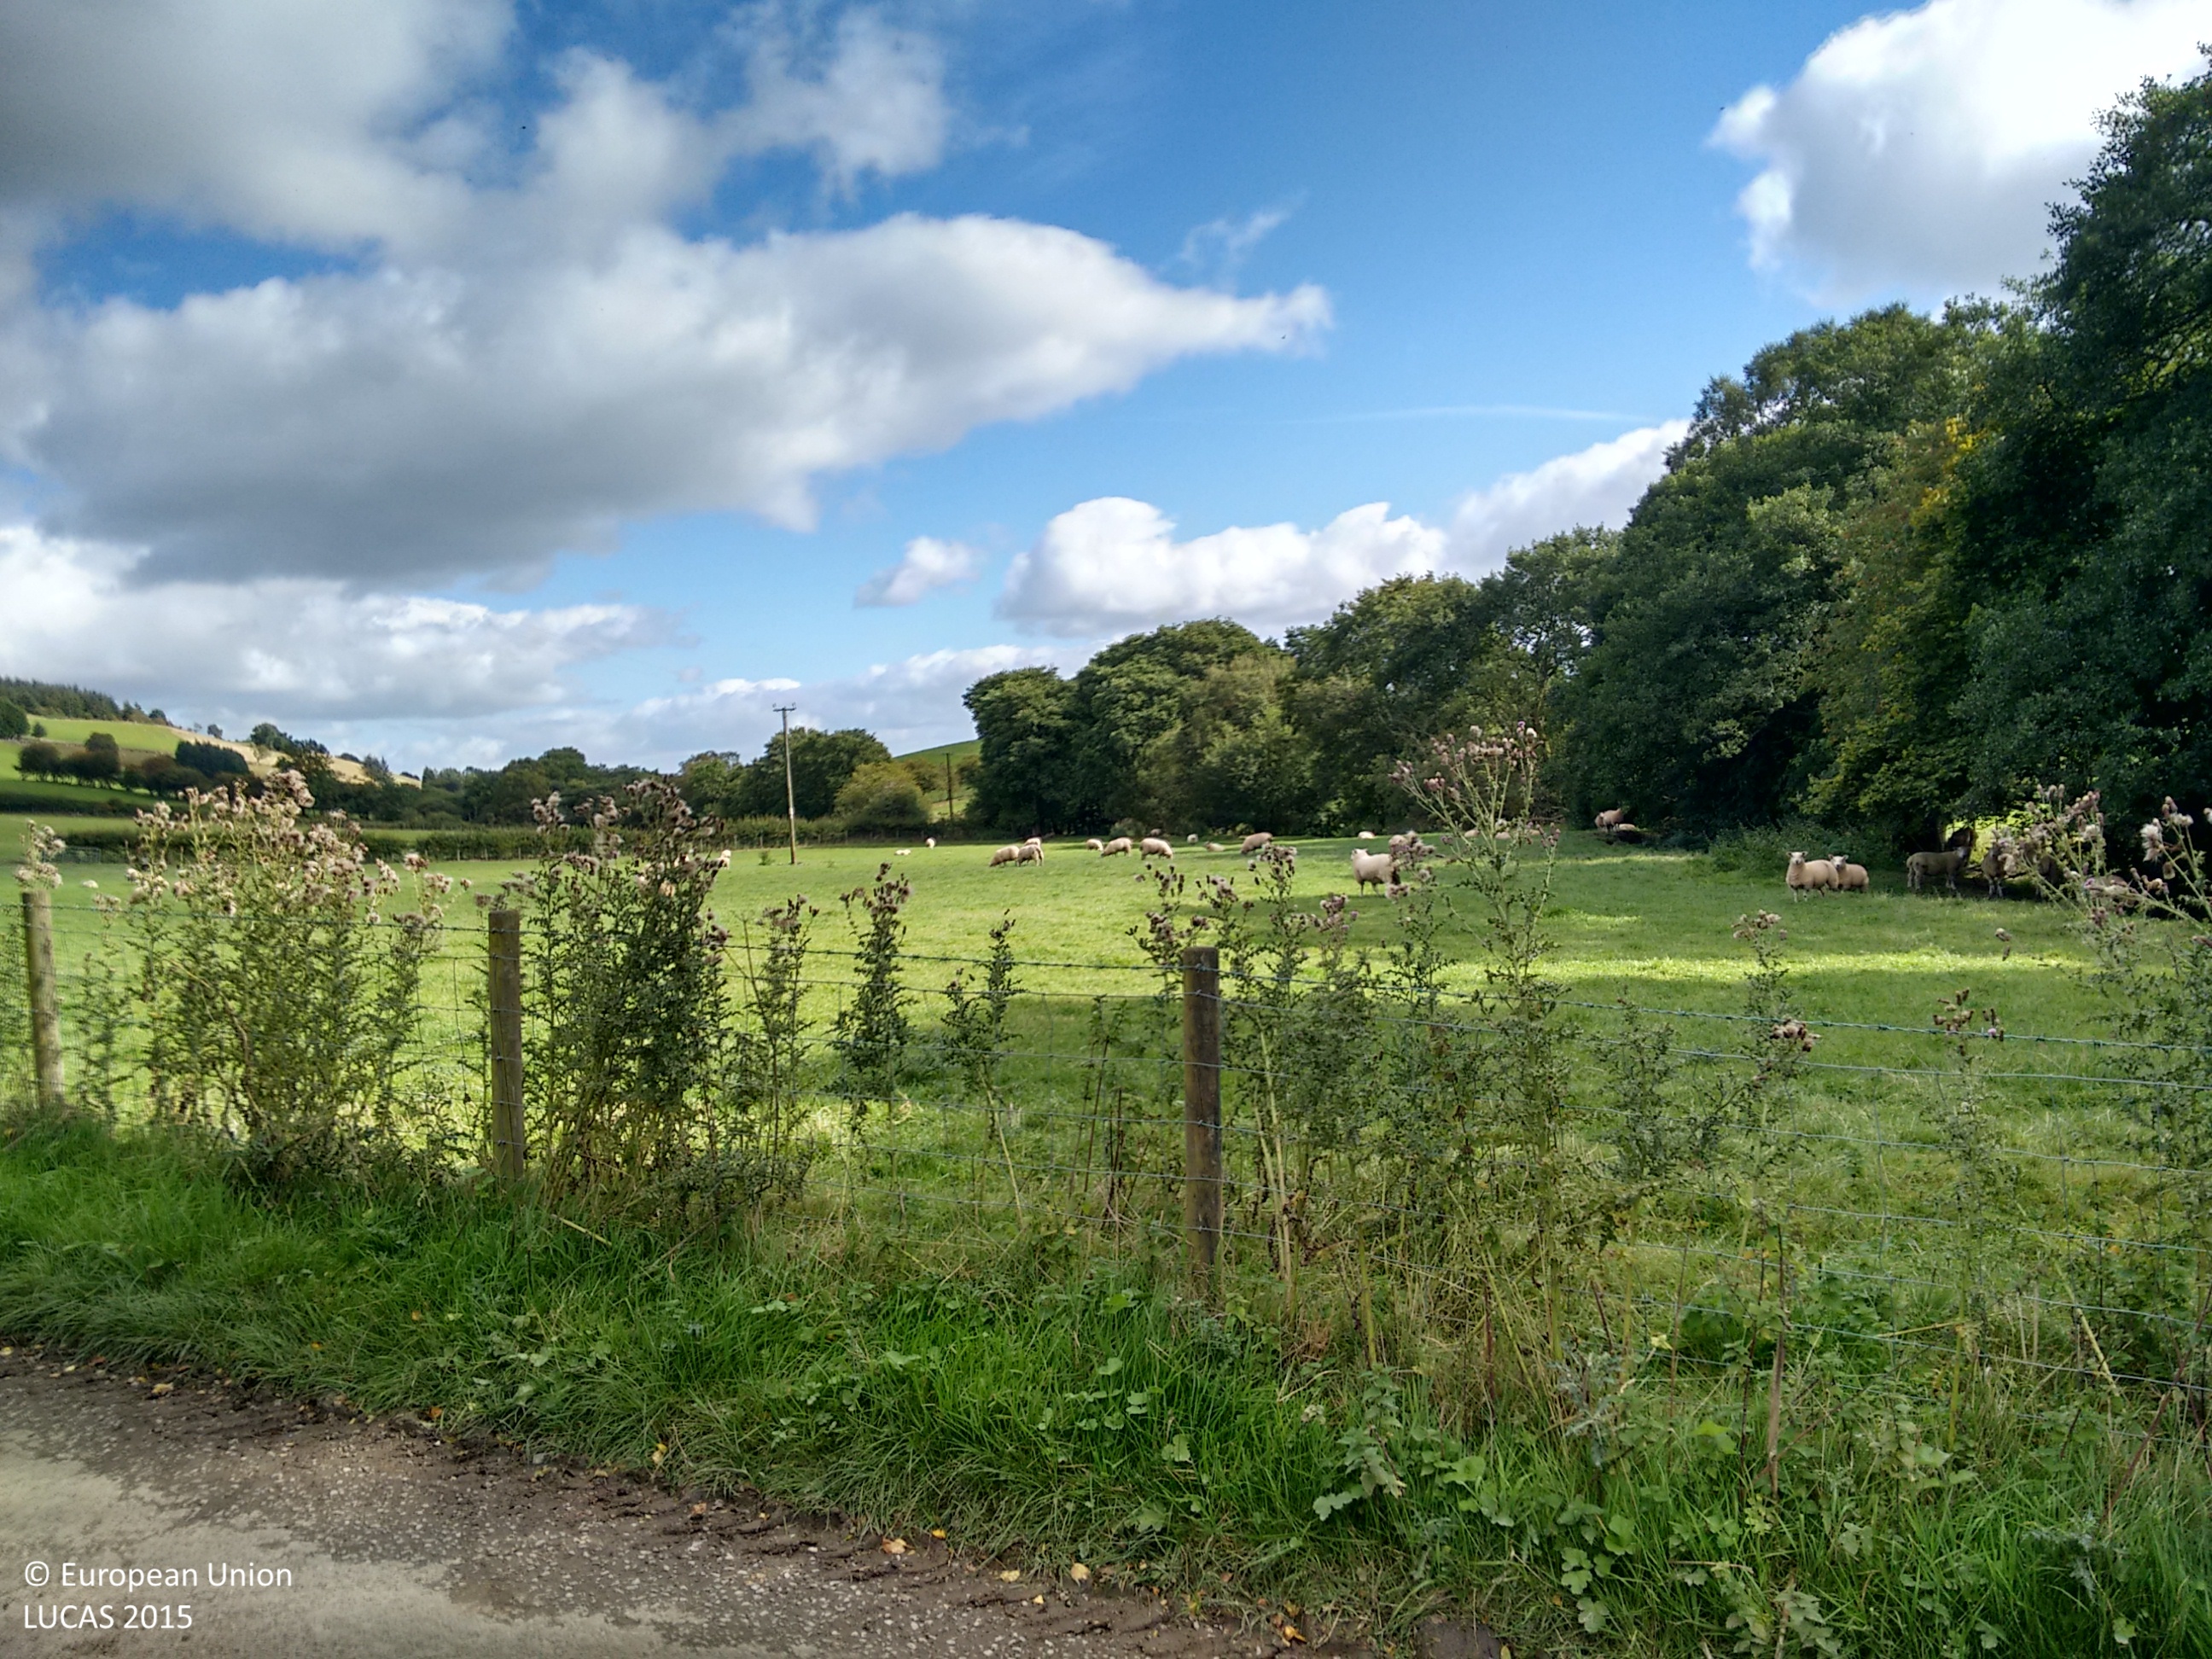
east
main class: Grassland
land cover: Grassland without tree/shrub cover
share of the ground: > 75 %
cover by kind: herbaceous plants 100 %
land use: Agriculture (excluding fallow land and kitchen gardens)
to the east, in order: Grassland without tree/shrub cover; Electric lines; Grassland without tree/shrub cover; Fences; Rivers and streams; Managed hedges; Grass margins; Paved roads, cycling and walking lanes; Grass margins; Fences; Grassland without tree/shrub cover; Electric lines; Grassland without tree/shrub cover
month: September
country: GB
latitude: 53.0710
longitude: -3.4104
